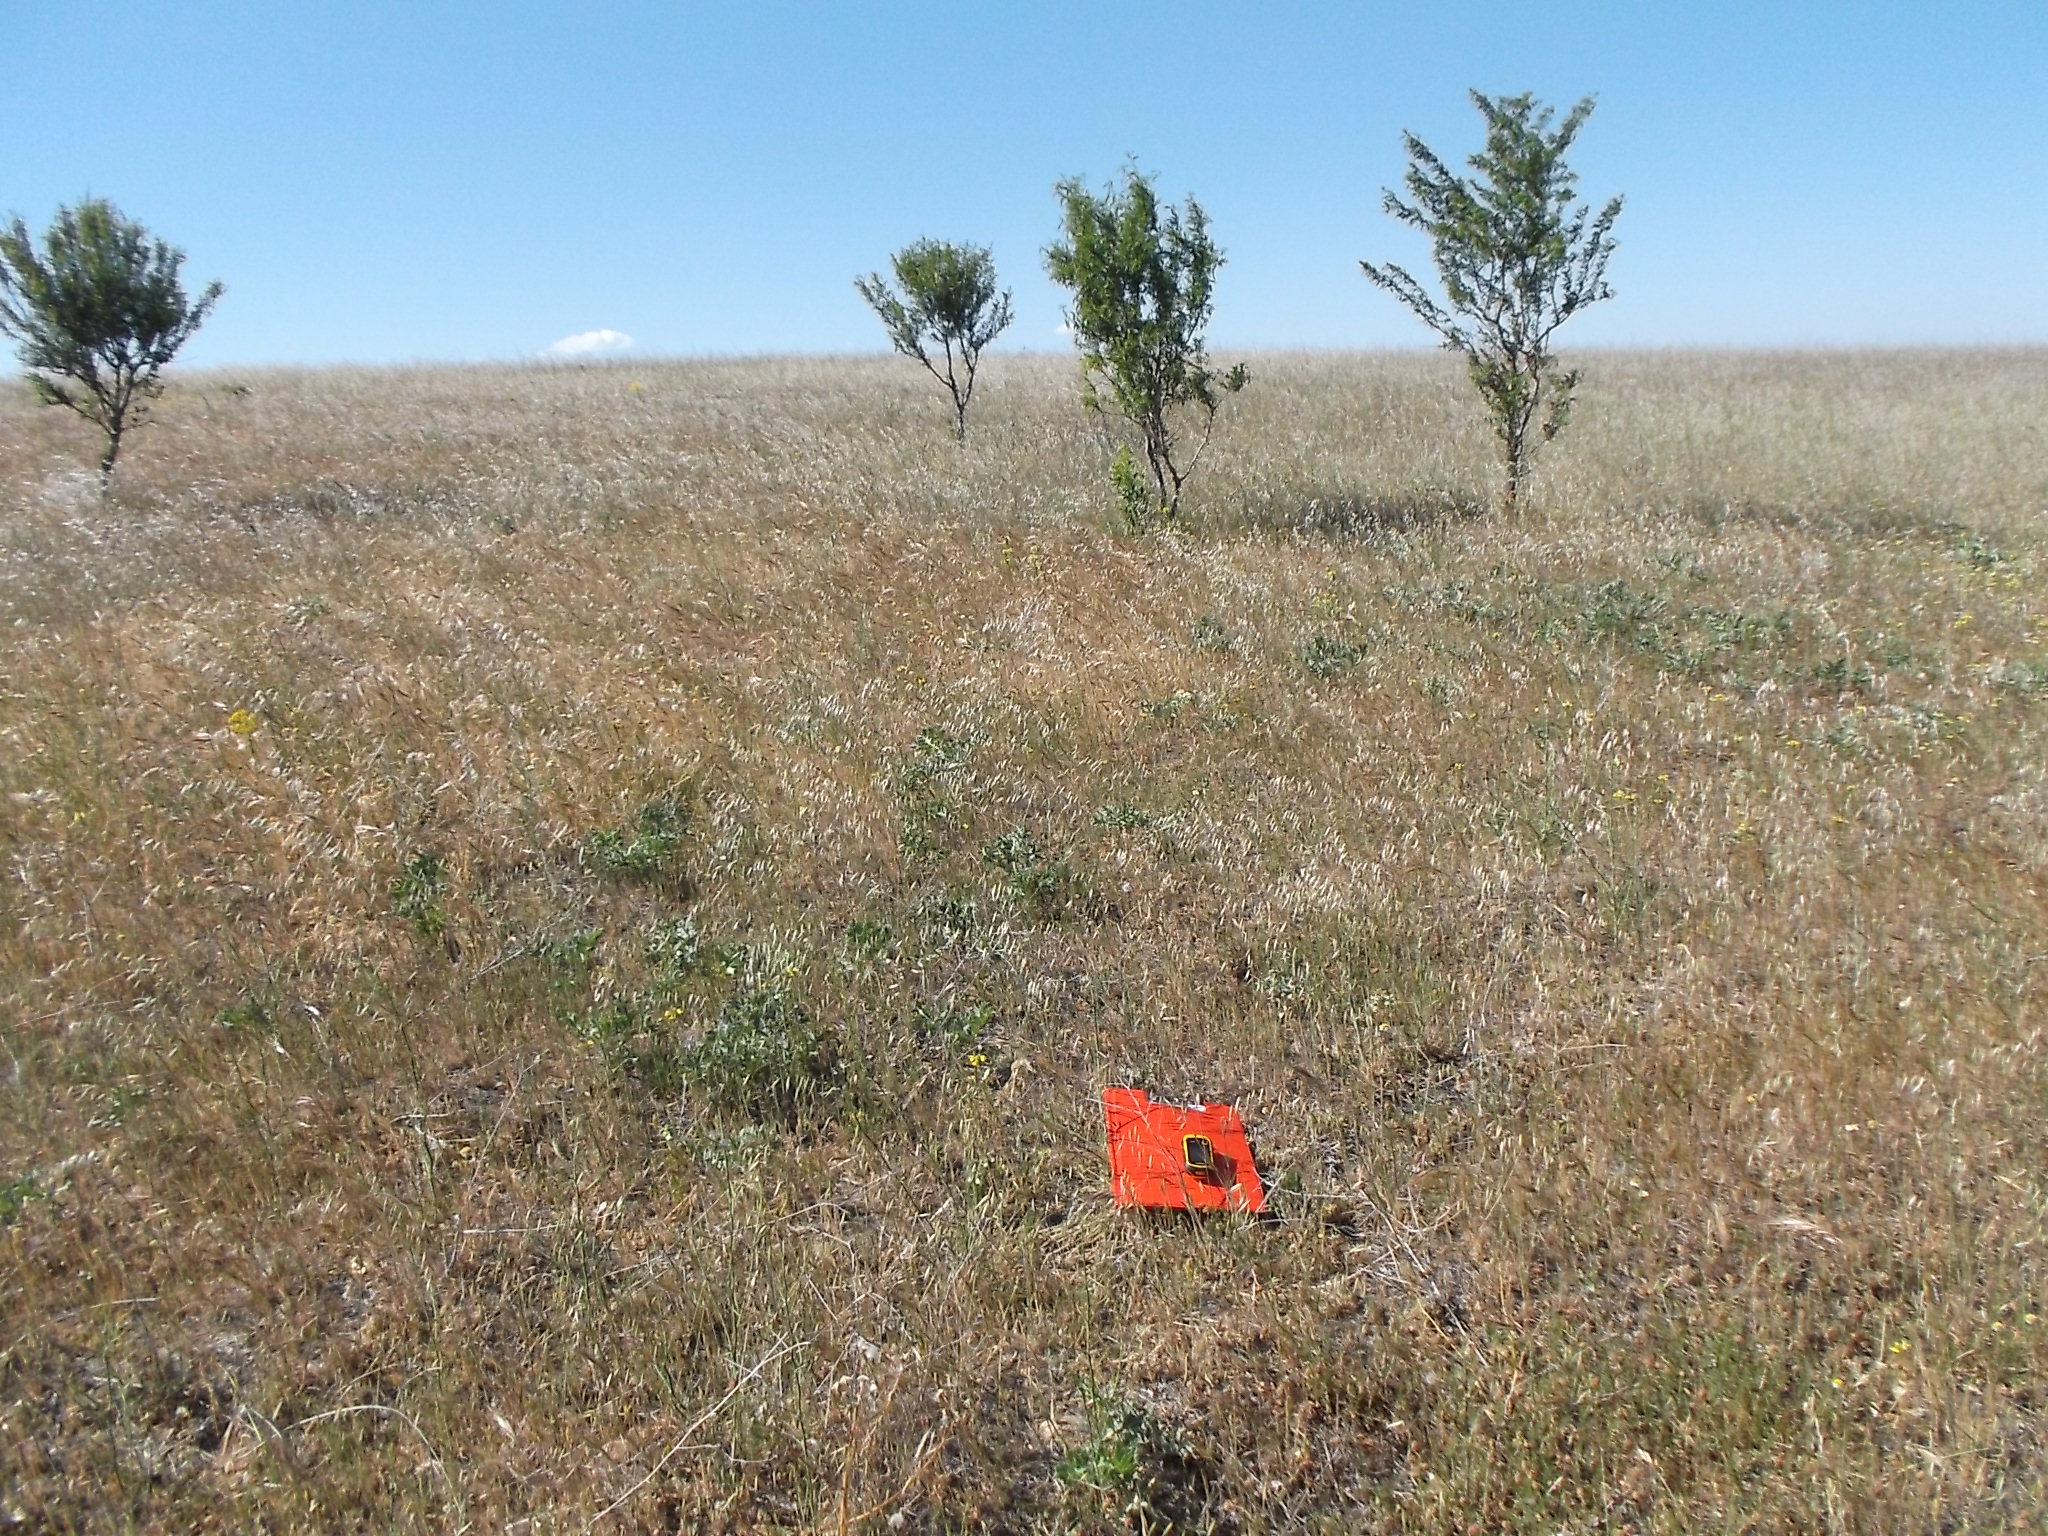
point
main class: Grassland
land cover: Grassland without tree/shrub cover
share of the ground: > 75 %
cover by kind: herbaceous plants 95 %, shrubs 5 %
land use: Abandoned areas
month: May
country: ES
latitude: 41.2249
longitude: -5.4291
